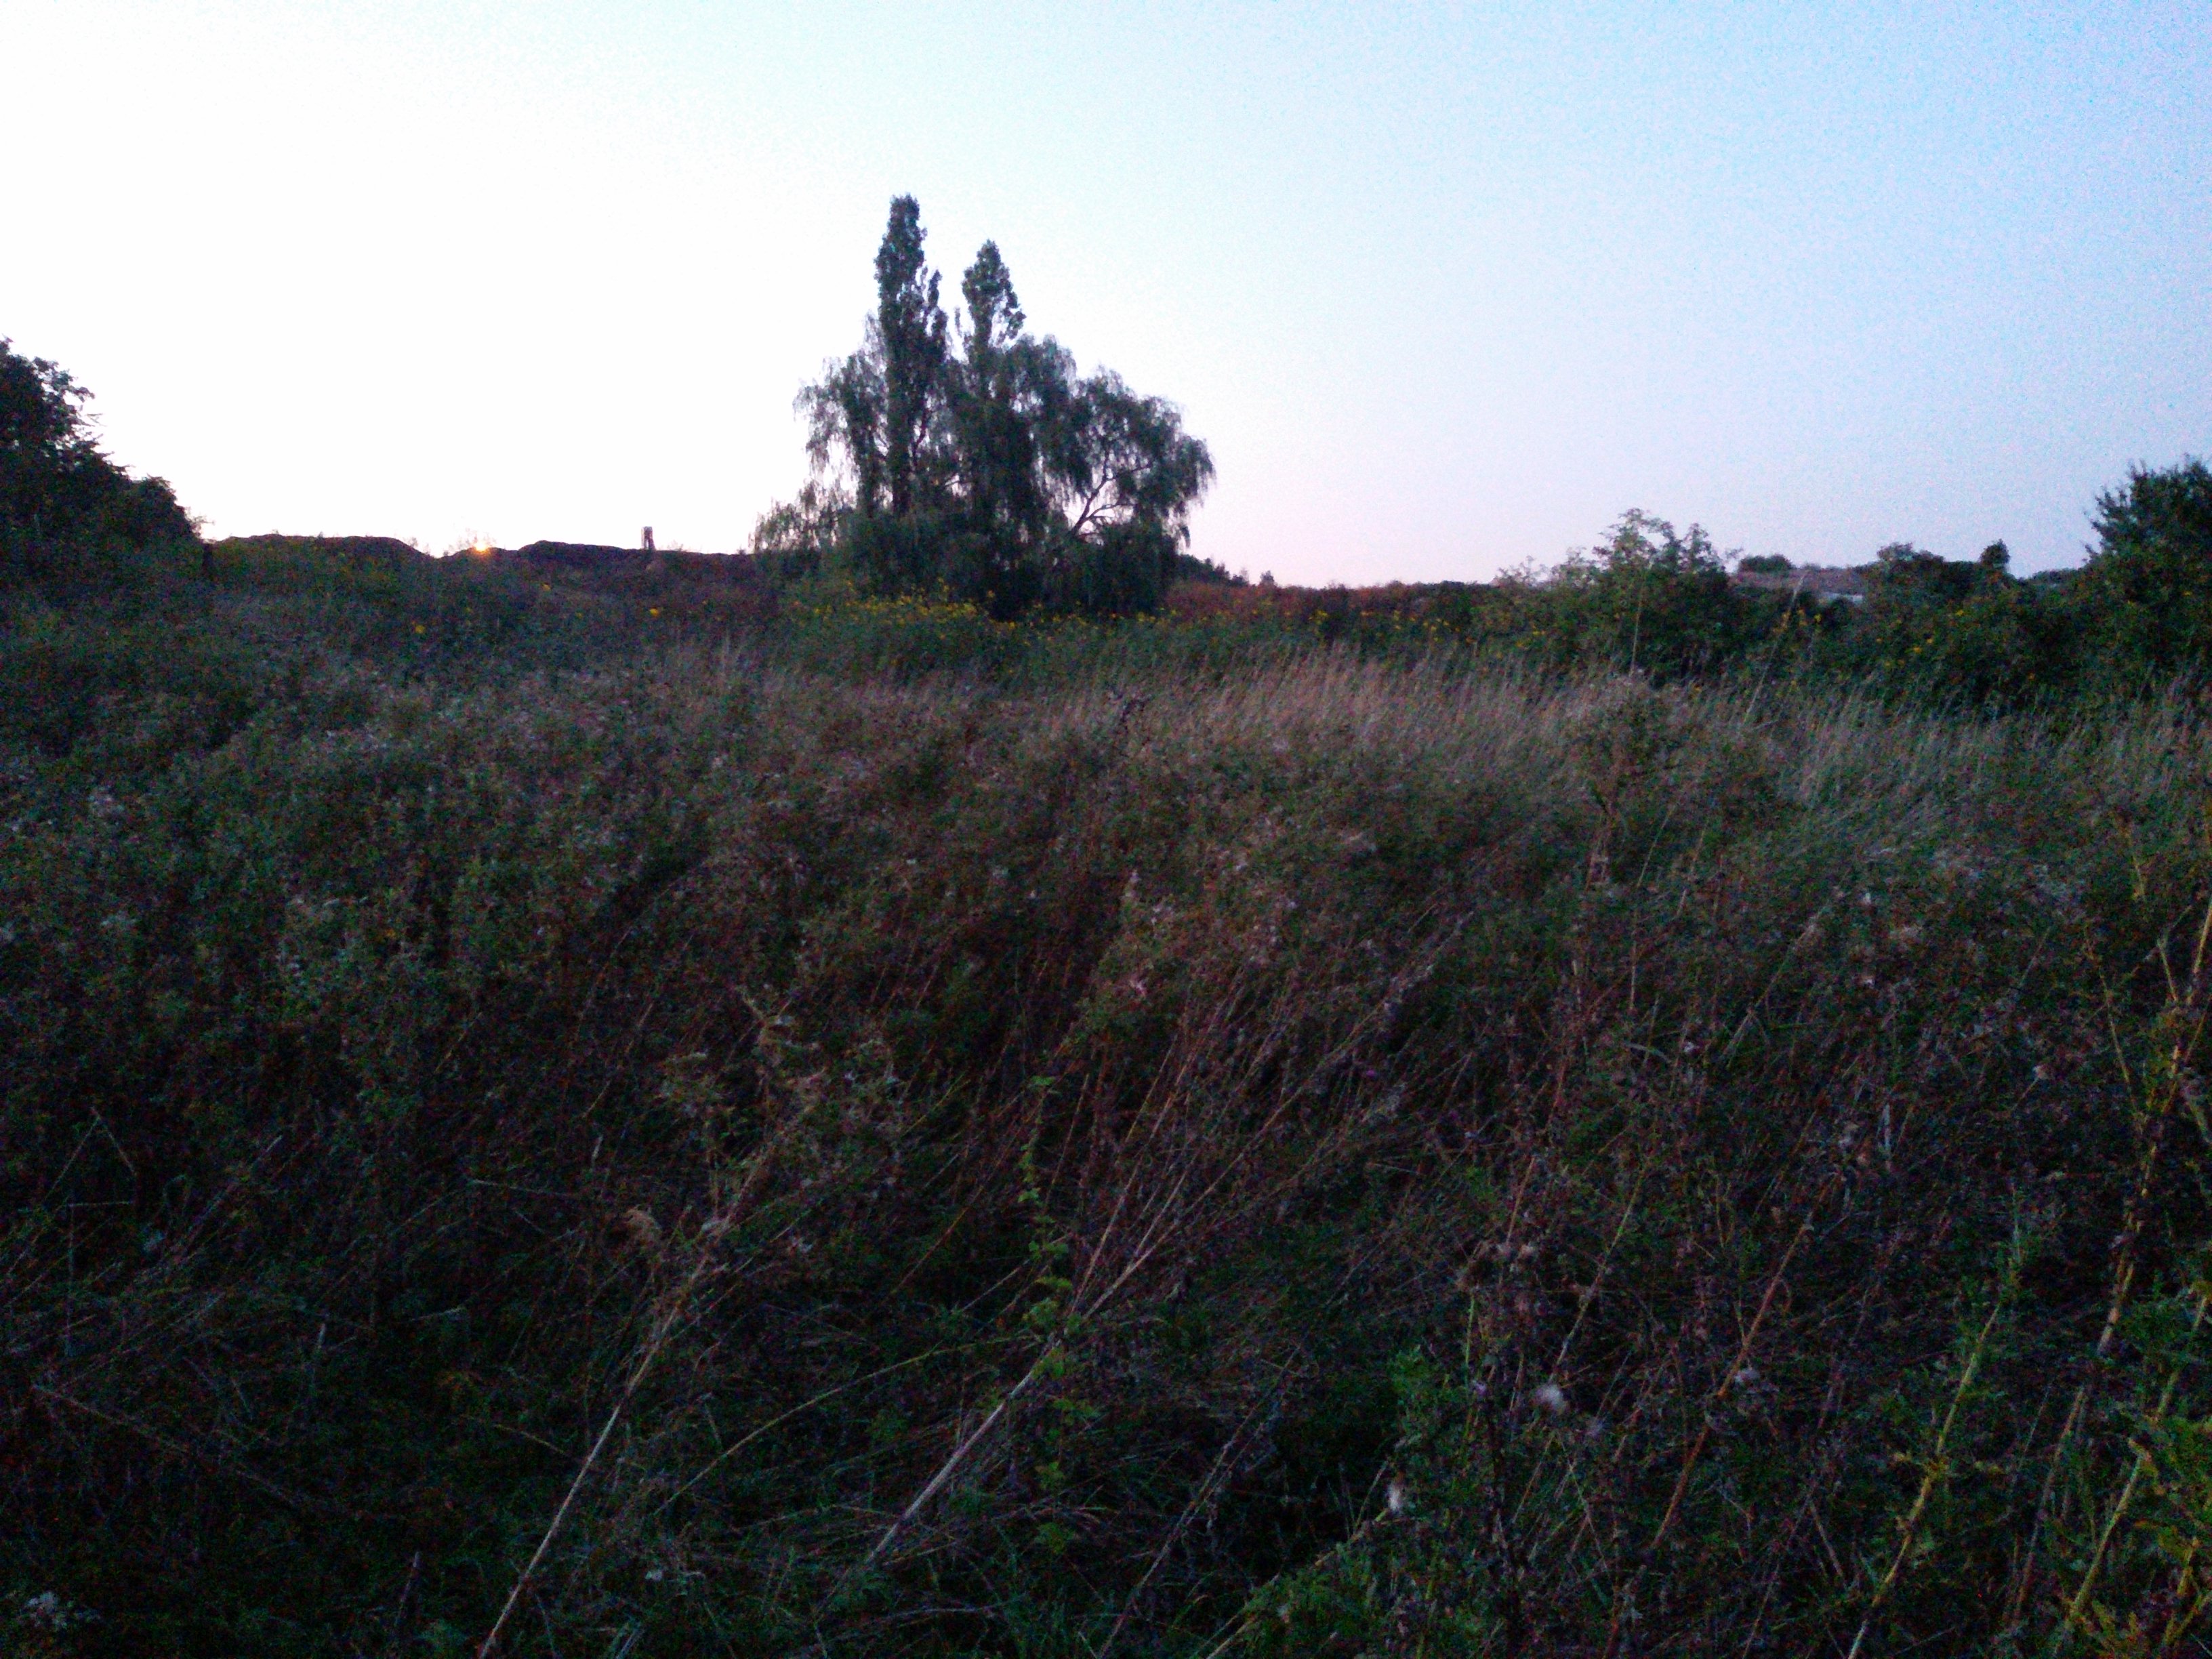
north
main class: Grassland
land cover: Spontaneously vegetated surfaces
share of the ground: > 75 %
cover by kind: herbaceous plants 100 %
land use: Semi-natural and natural areas not in use
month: September
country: PL
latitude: 53.1435
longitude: 17.6224
